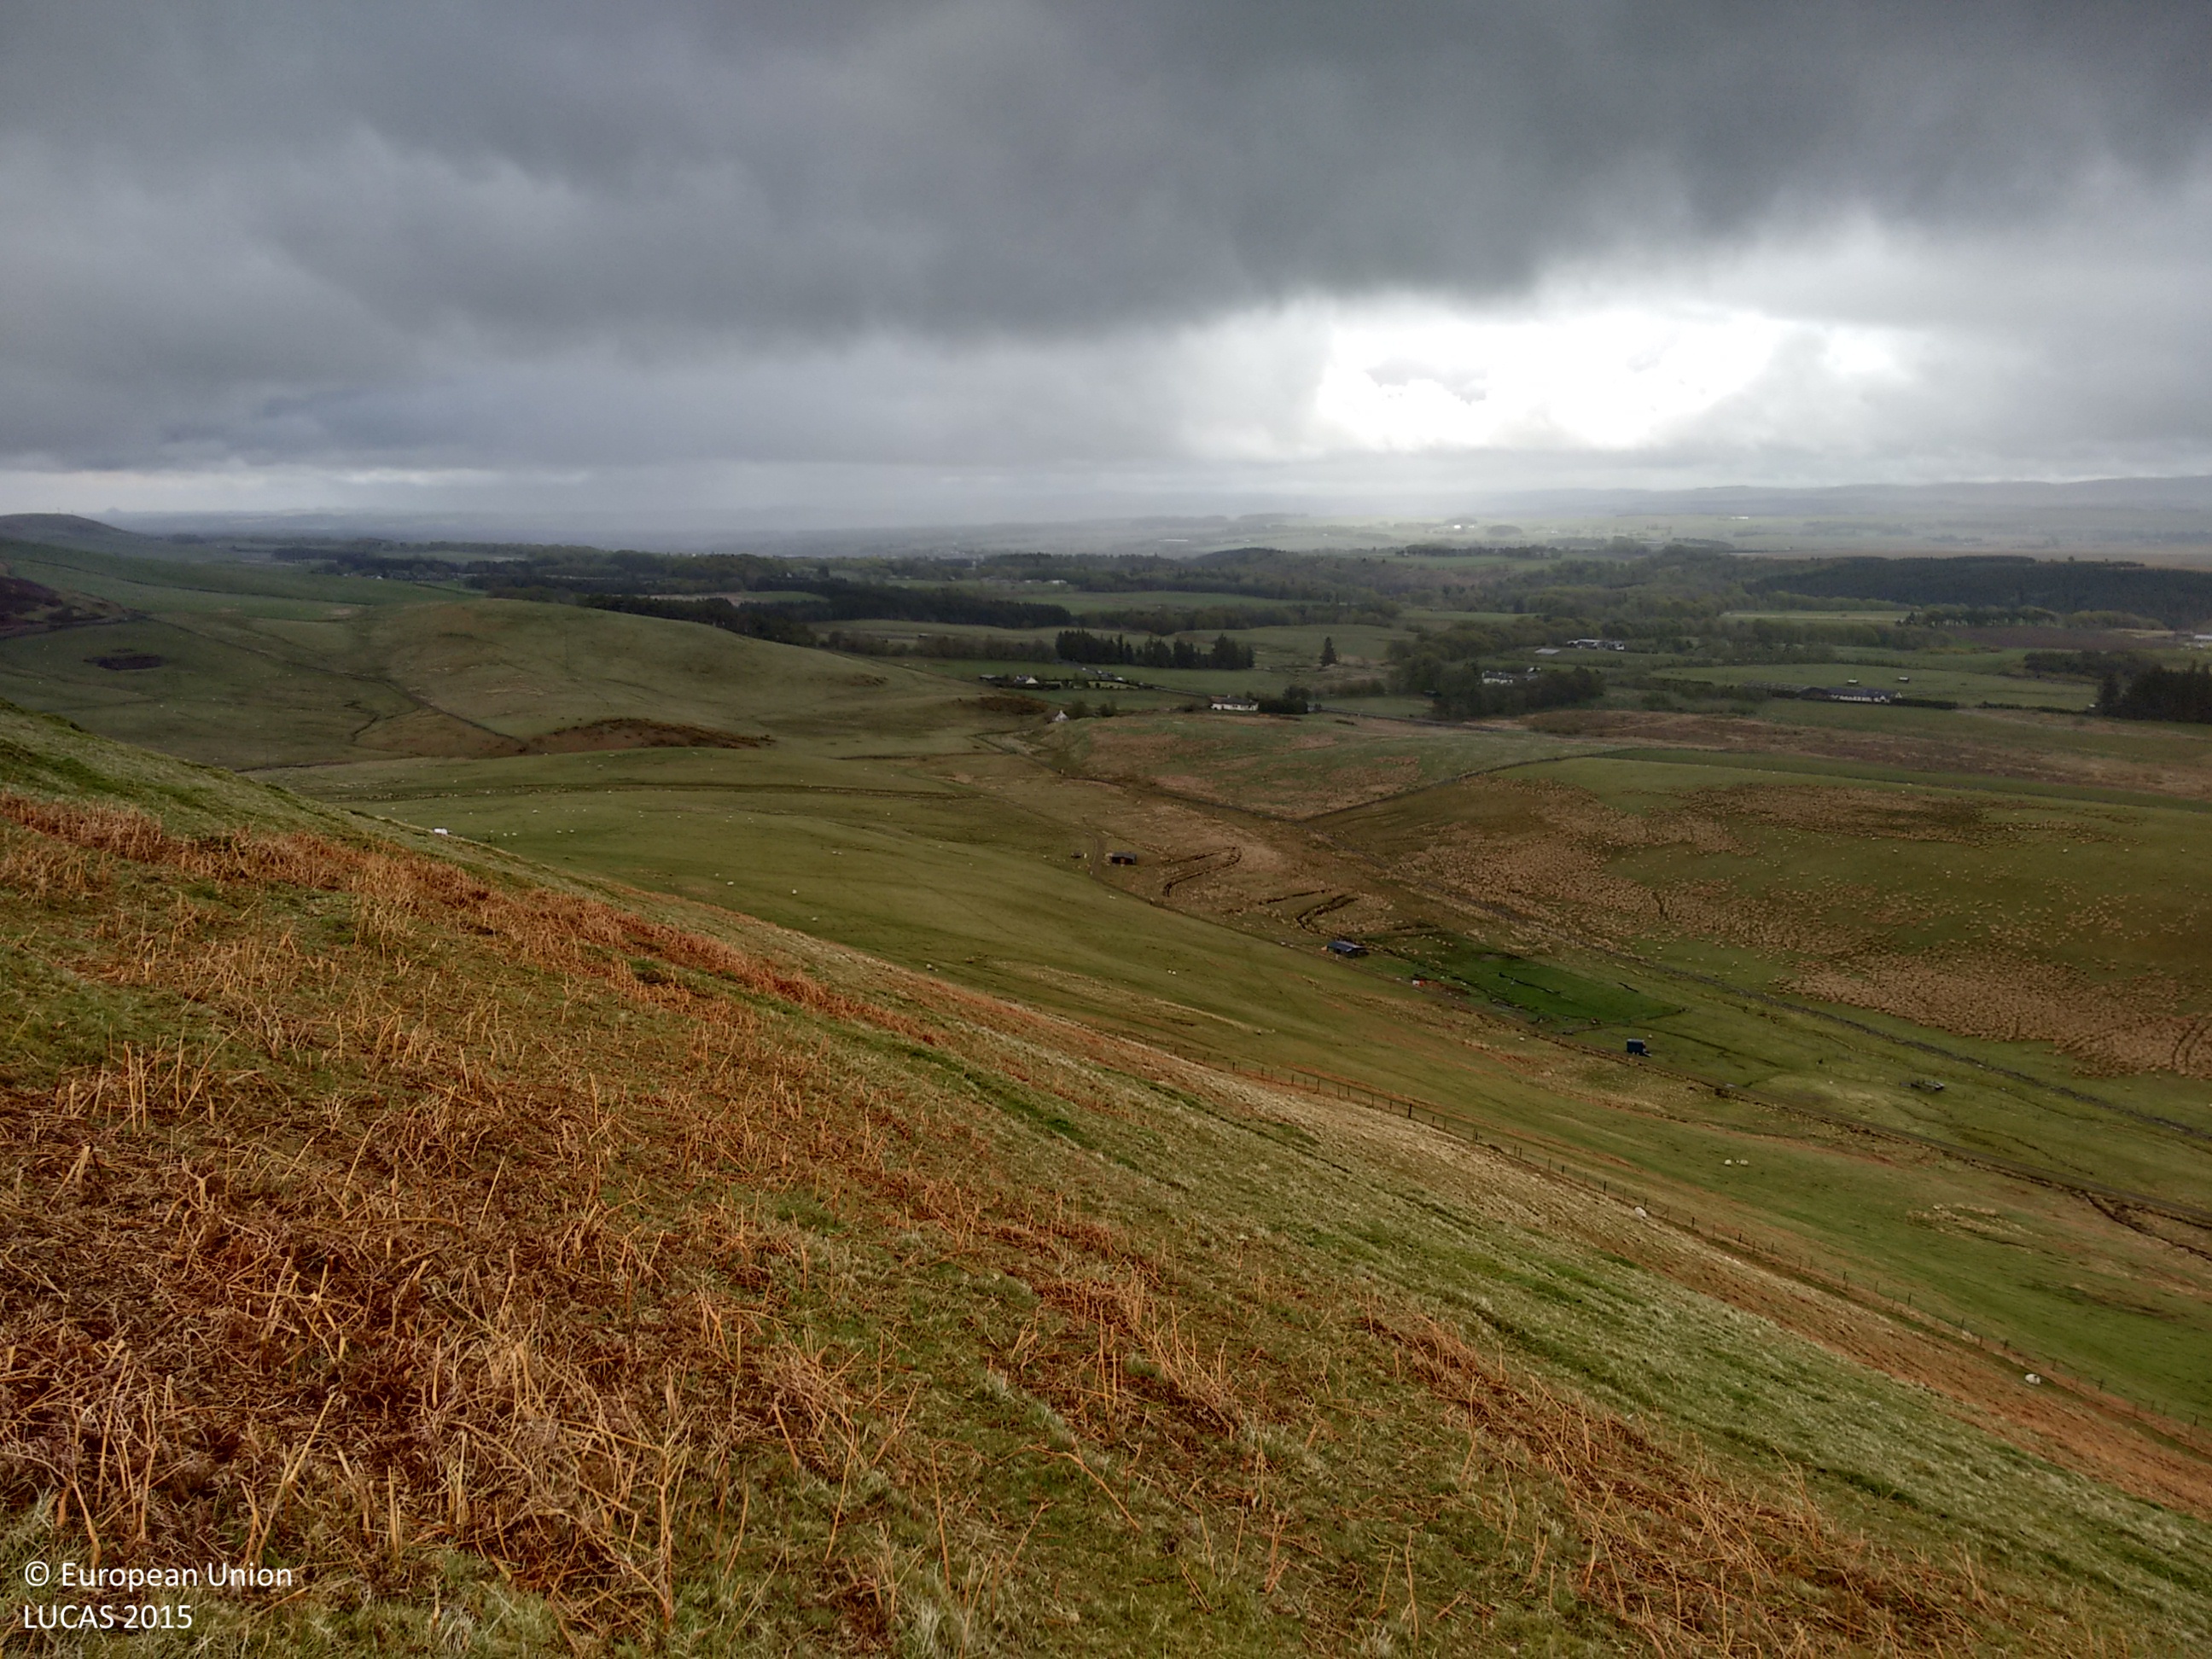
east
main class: Grassland
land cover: Grassland without tree/shrub cover
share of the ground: > 75 %
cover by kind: herbaceous plants 100 %
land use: Agriculture (excluding fallow land and kitchen gardens)
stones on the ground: < 10 %
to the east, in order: Grassland without tree/shrub cover; Fences; Grassland without tree/shrub cover; Fences; Grassland without tree/shrub cover
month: May
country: GB
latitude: 55.8193
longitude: -3.3052
